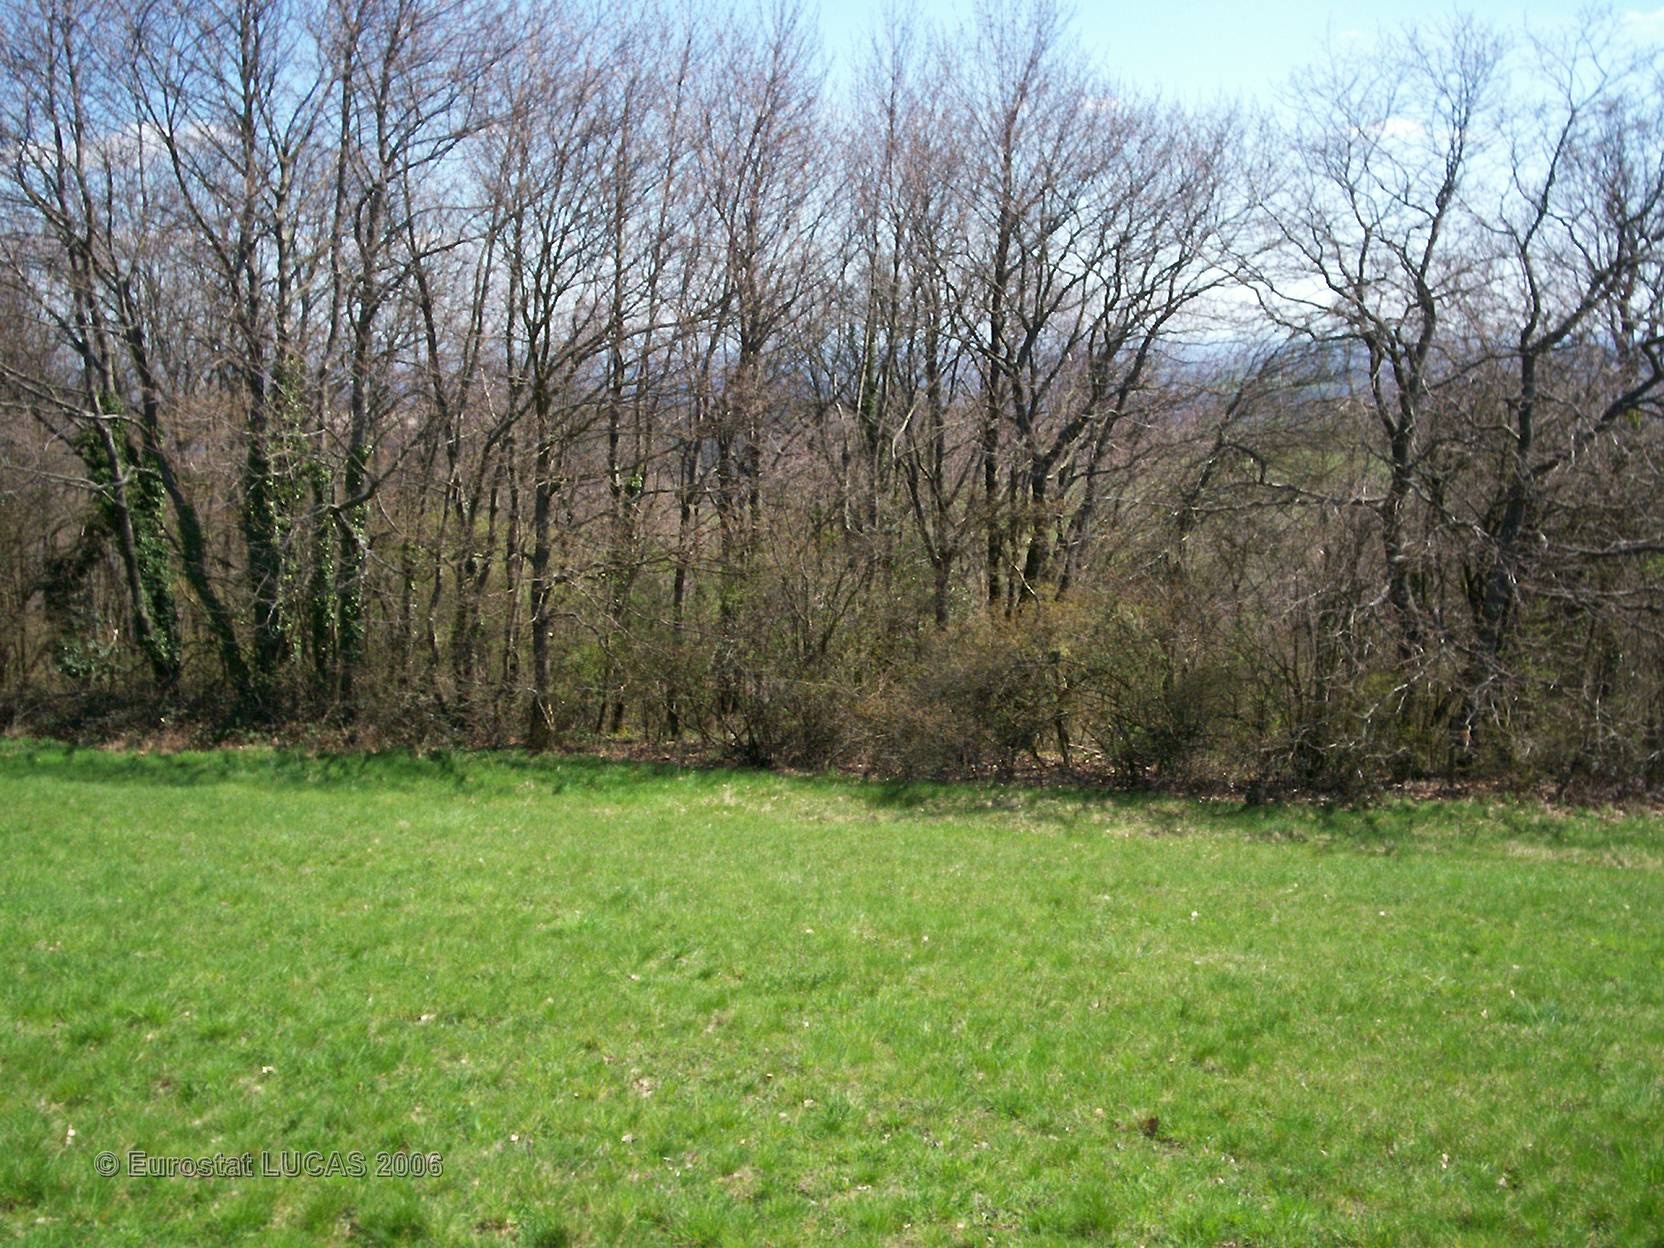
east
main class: Grassland
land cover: Grassland without tree/shrub cover
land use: Agriculture (excluding fallow land and kitchen gardens)
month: April
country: FR
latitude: 46.4379
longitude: 4.7306
